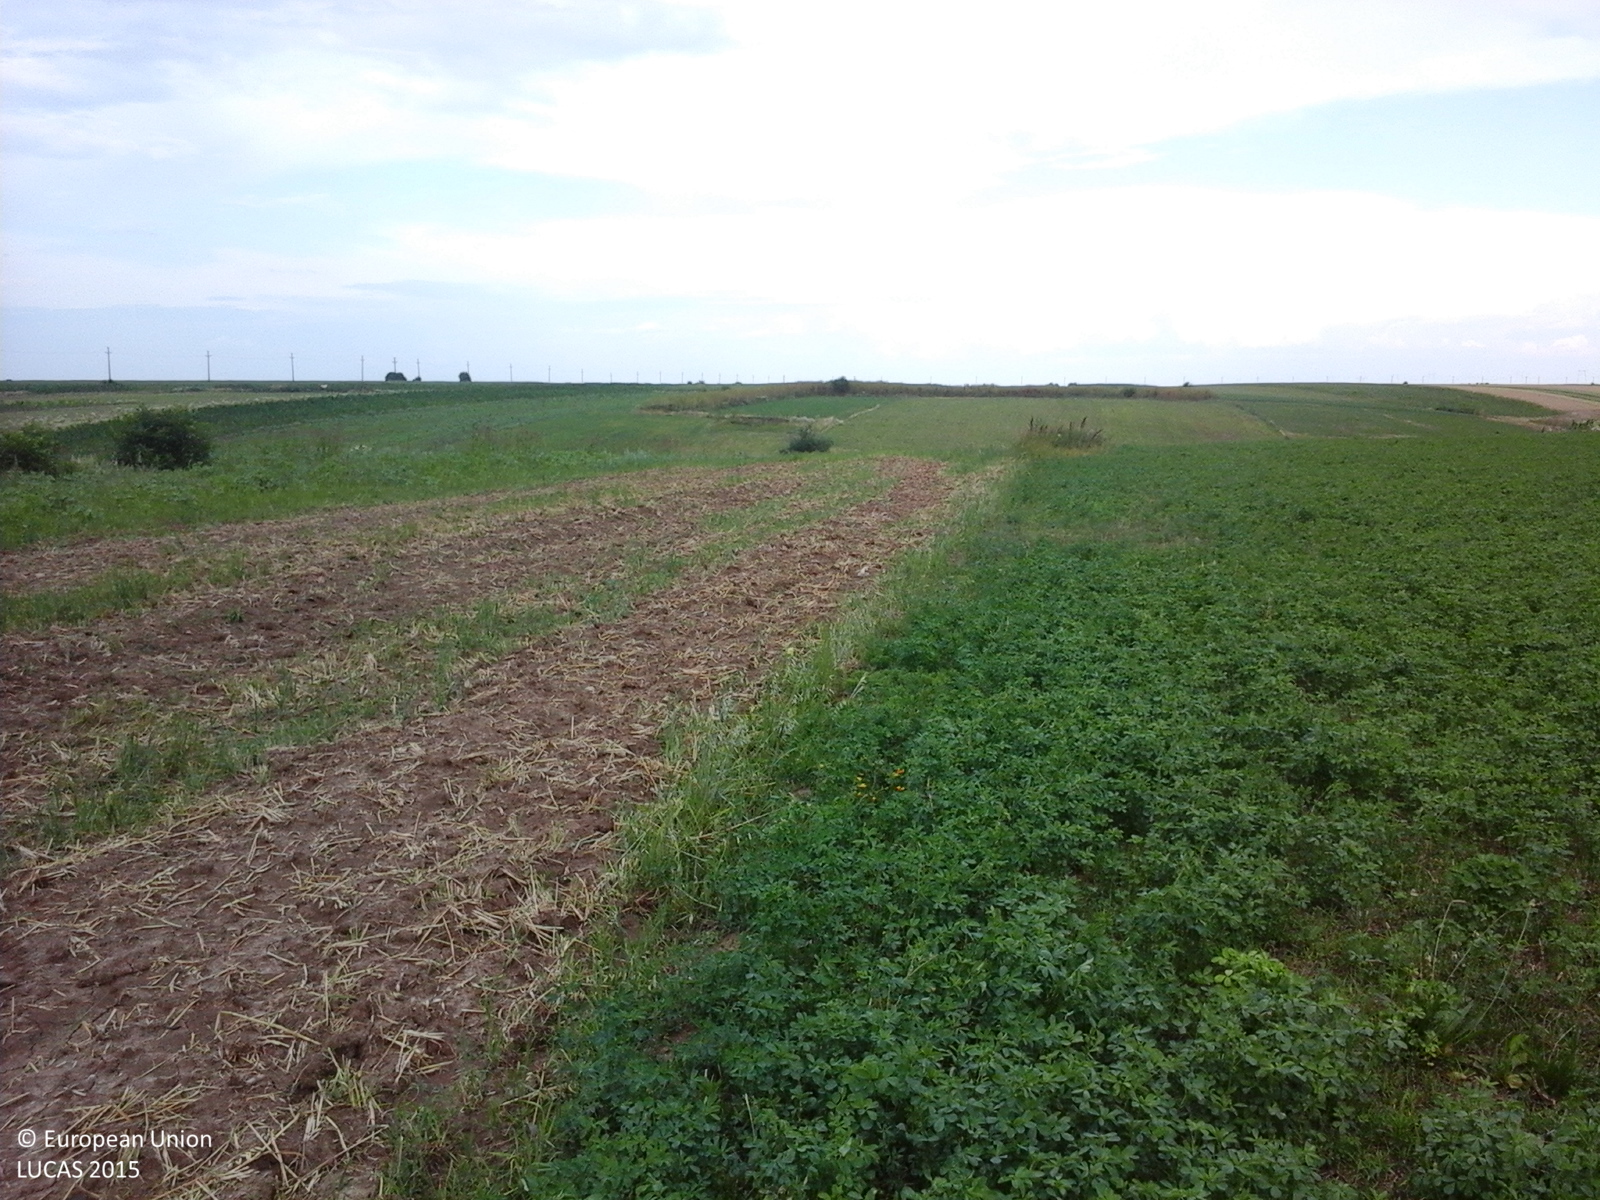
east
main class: Cropland
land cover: Lucerne
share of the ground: > 75 %
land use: Agriculture (excluding fallow land and kitchen gardens)
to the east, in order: Lucerne; Other bare soil; Grassland without tree/shrub cover
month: July
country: RO
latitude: 44.2664
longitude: 25.3313
